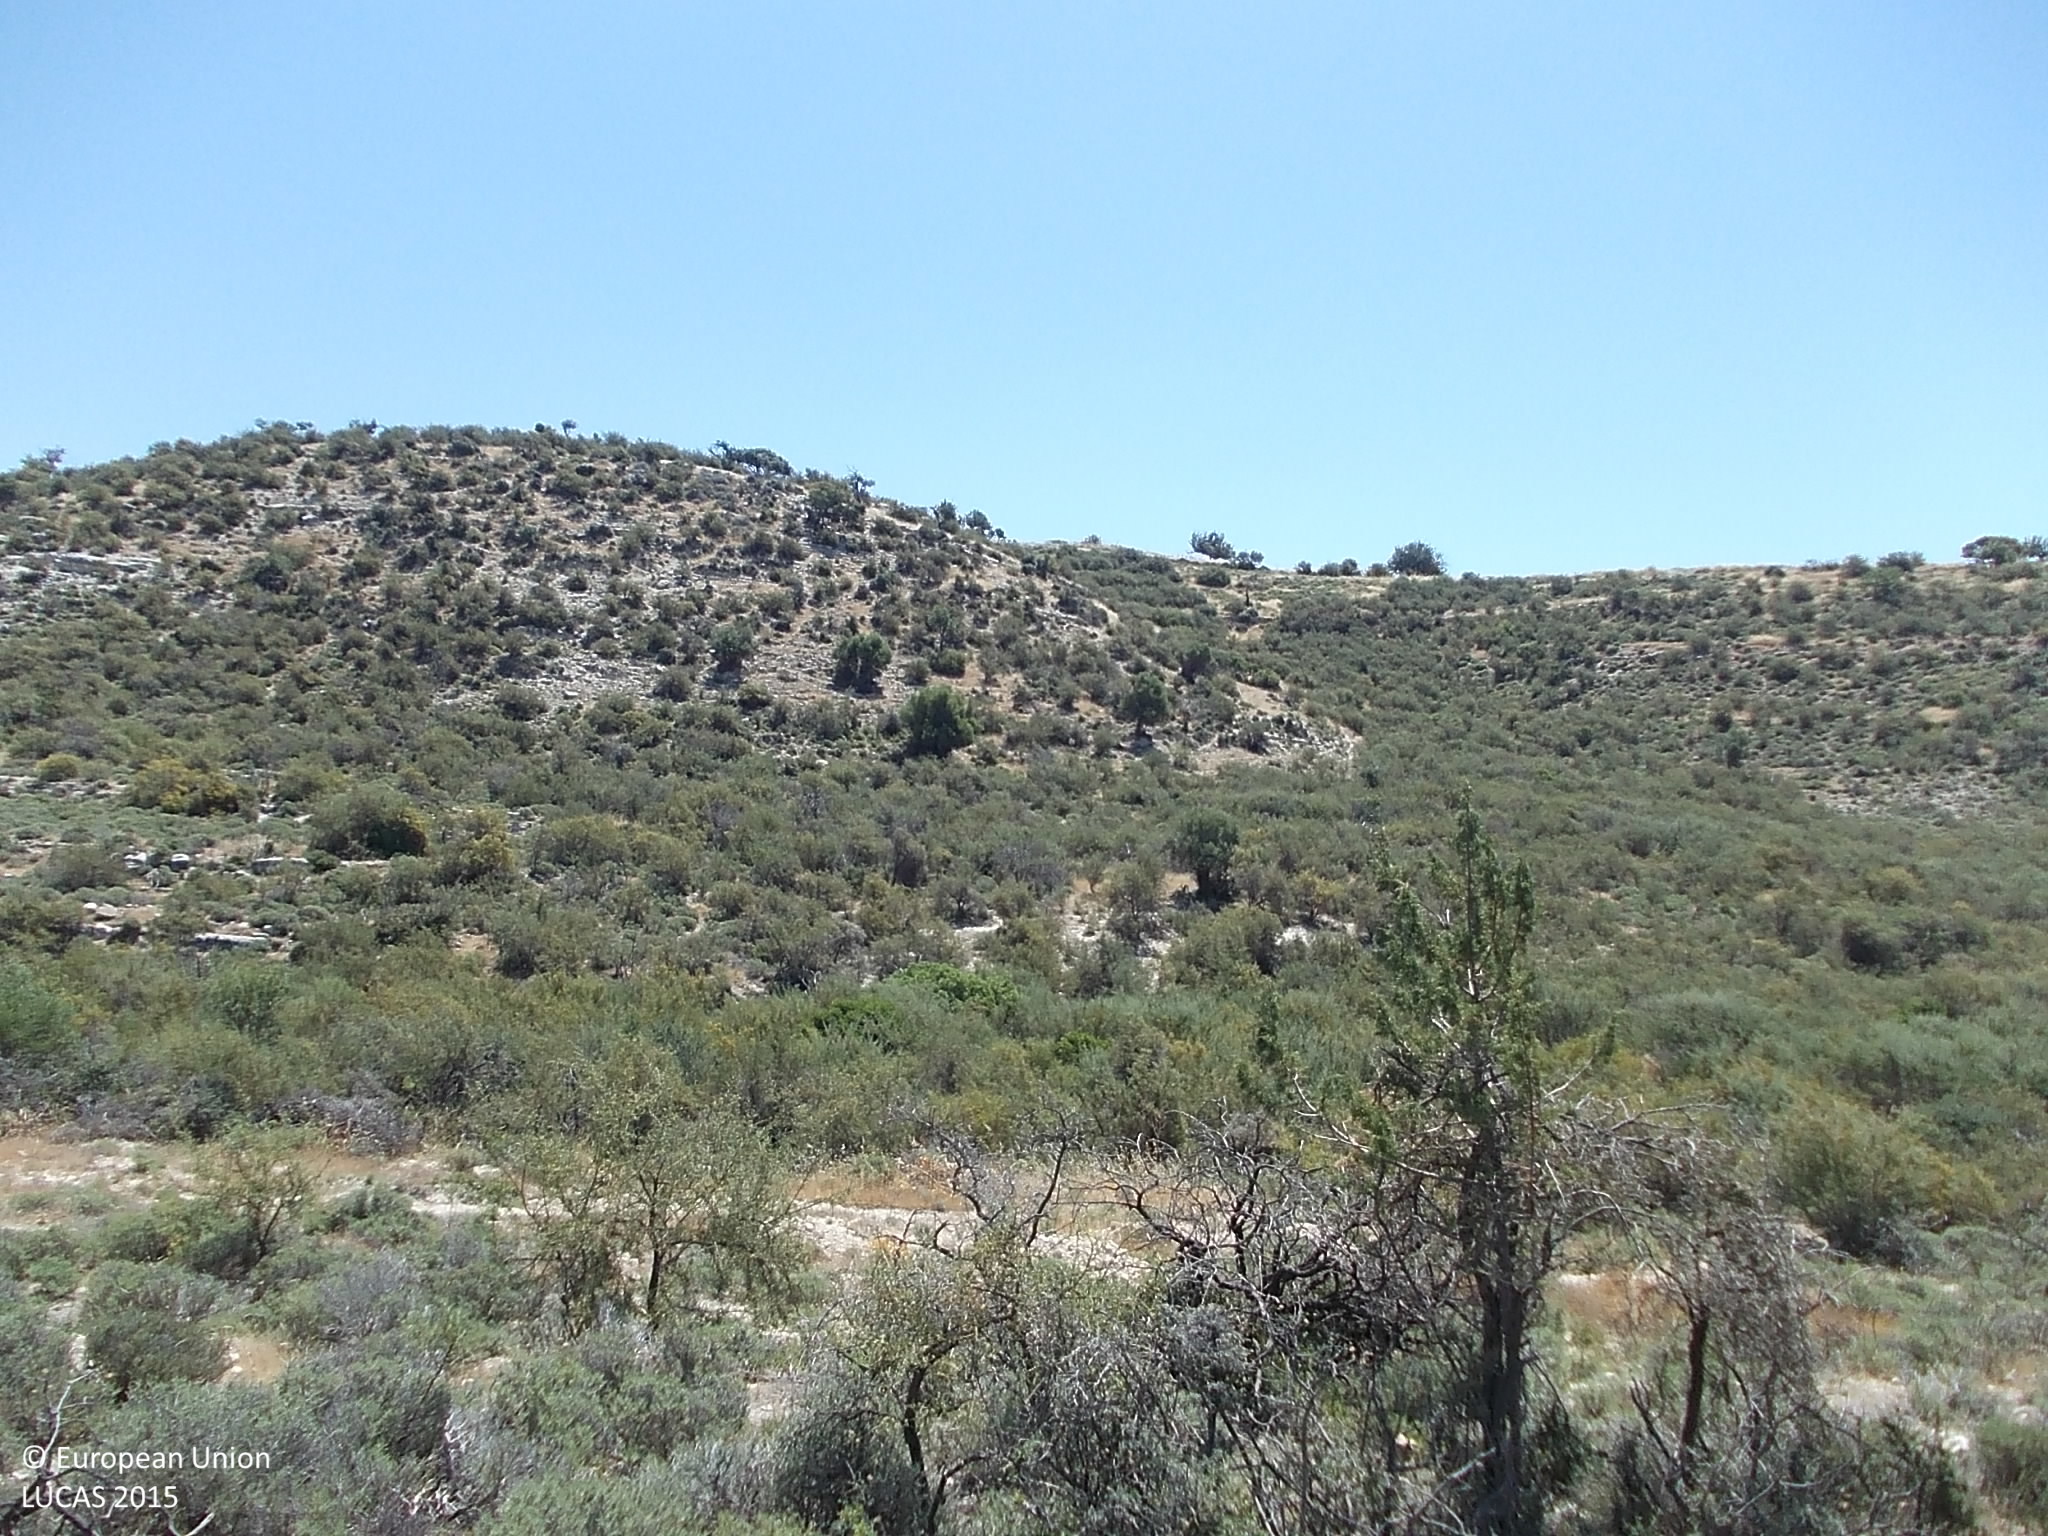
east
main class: Shrubland
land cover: Shrubland without tree cover
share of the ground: > 75 %
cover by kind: shrubs 80 %, unconsolidated bare surface 20 %
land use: Semi-natural and natural areas not in use
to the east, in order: Shrubland without tree cover; Tracks; Shrubland without tree cover; Grassland with sparse tree/shrub cover; Grassland without tree/shrub cover
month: May
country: CY
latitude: 34.6984
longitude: 32.7862
